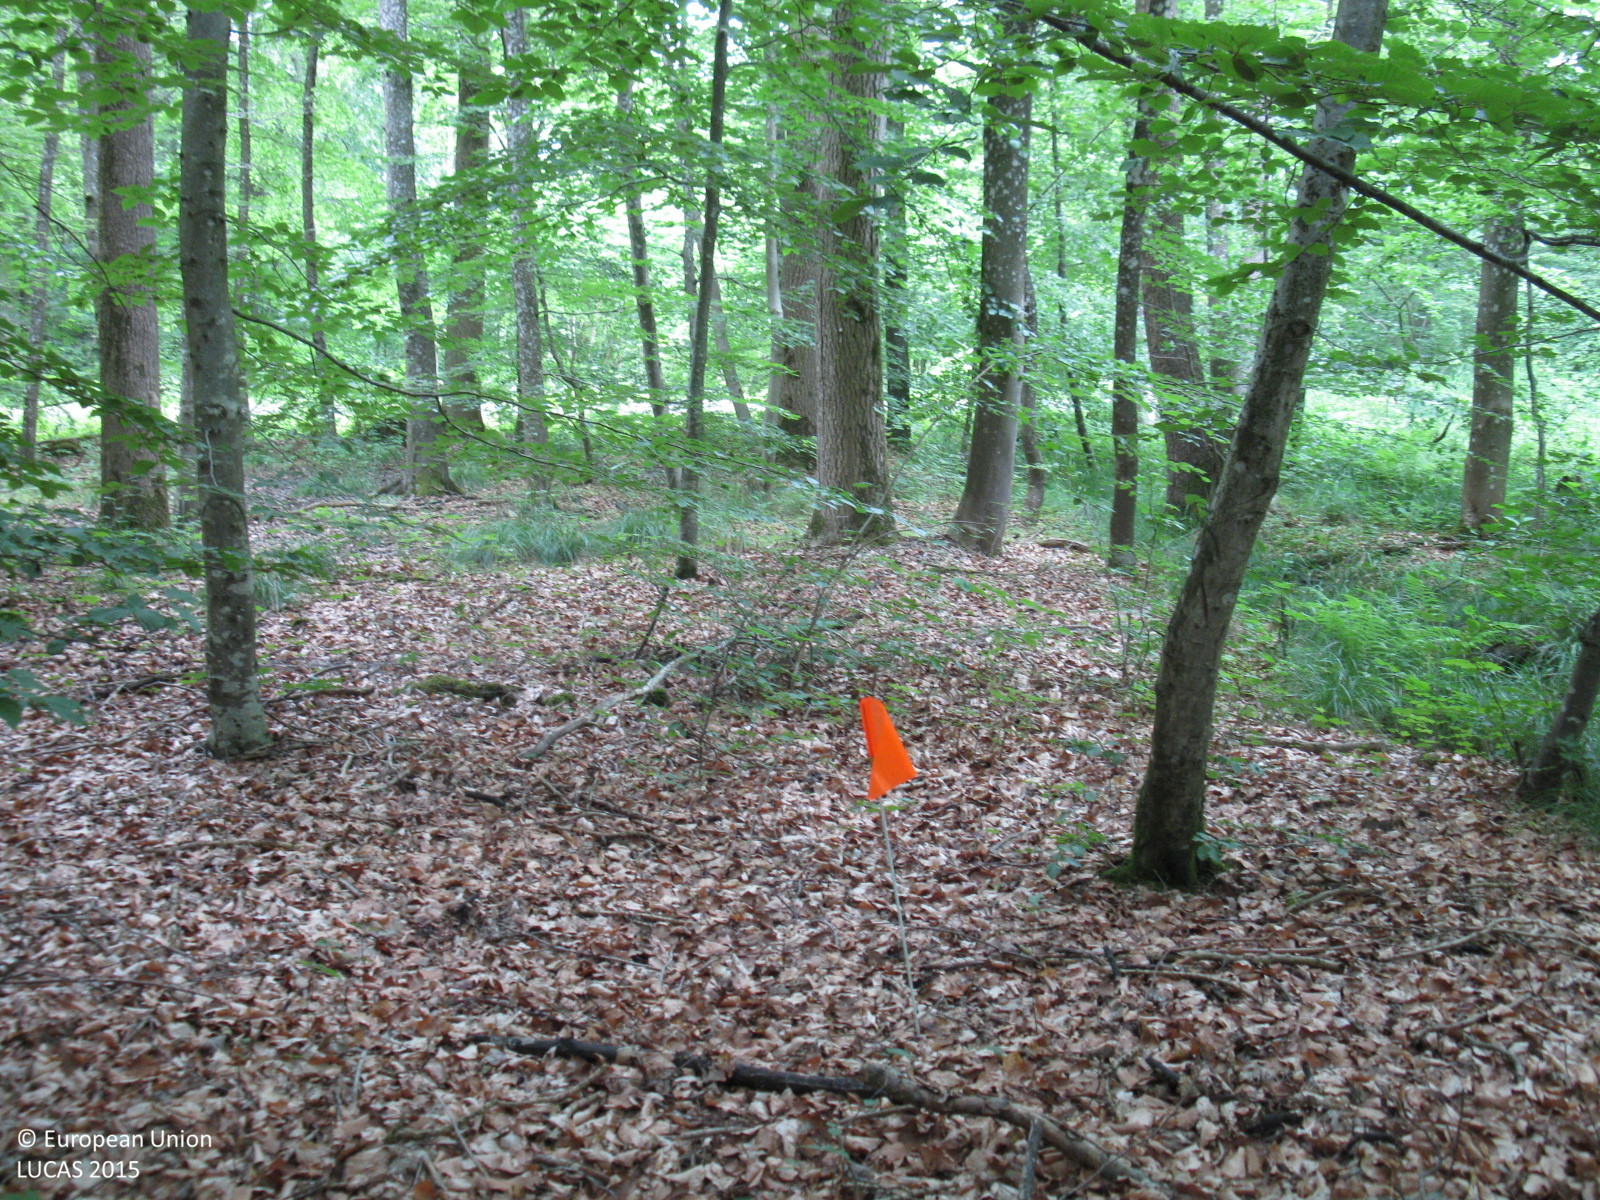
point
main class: Woodland
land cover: Broadleaved woodland
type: beech forest
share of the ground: > 75 %
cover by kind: broadleaved forest trees 100 %
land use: Forestry
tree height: > 5 m
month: June
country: DE
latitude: 53.5276
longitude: 7.9039
